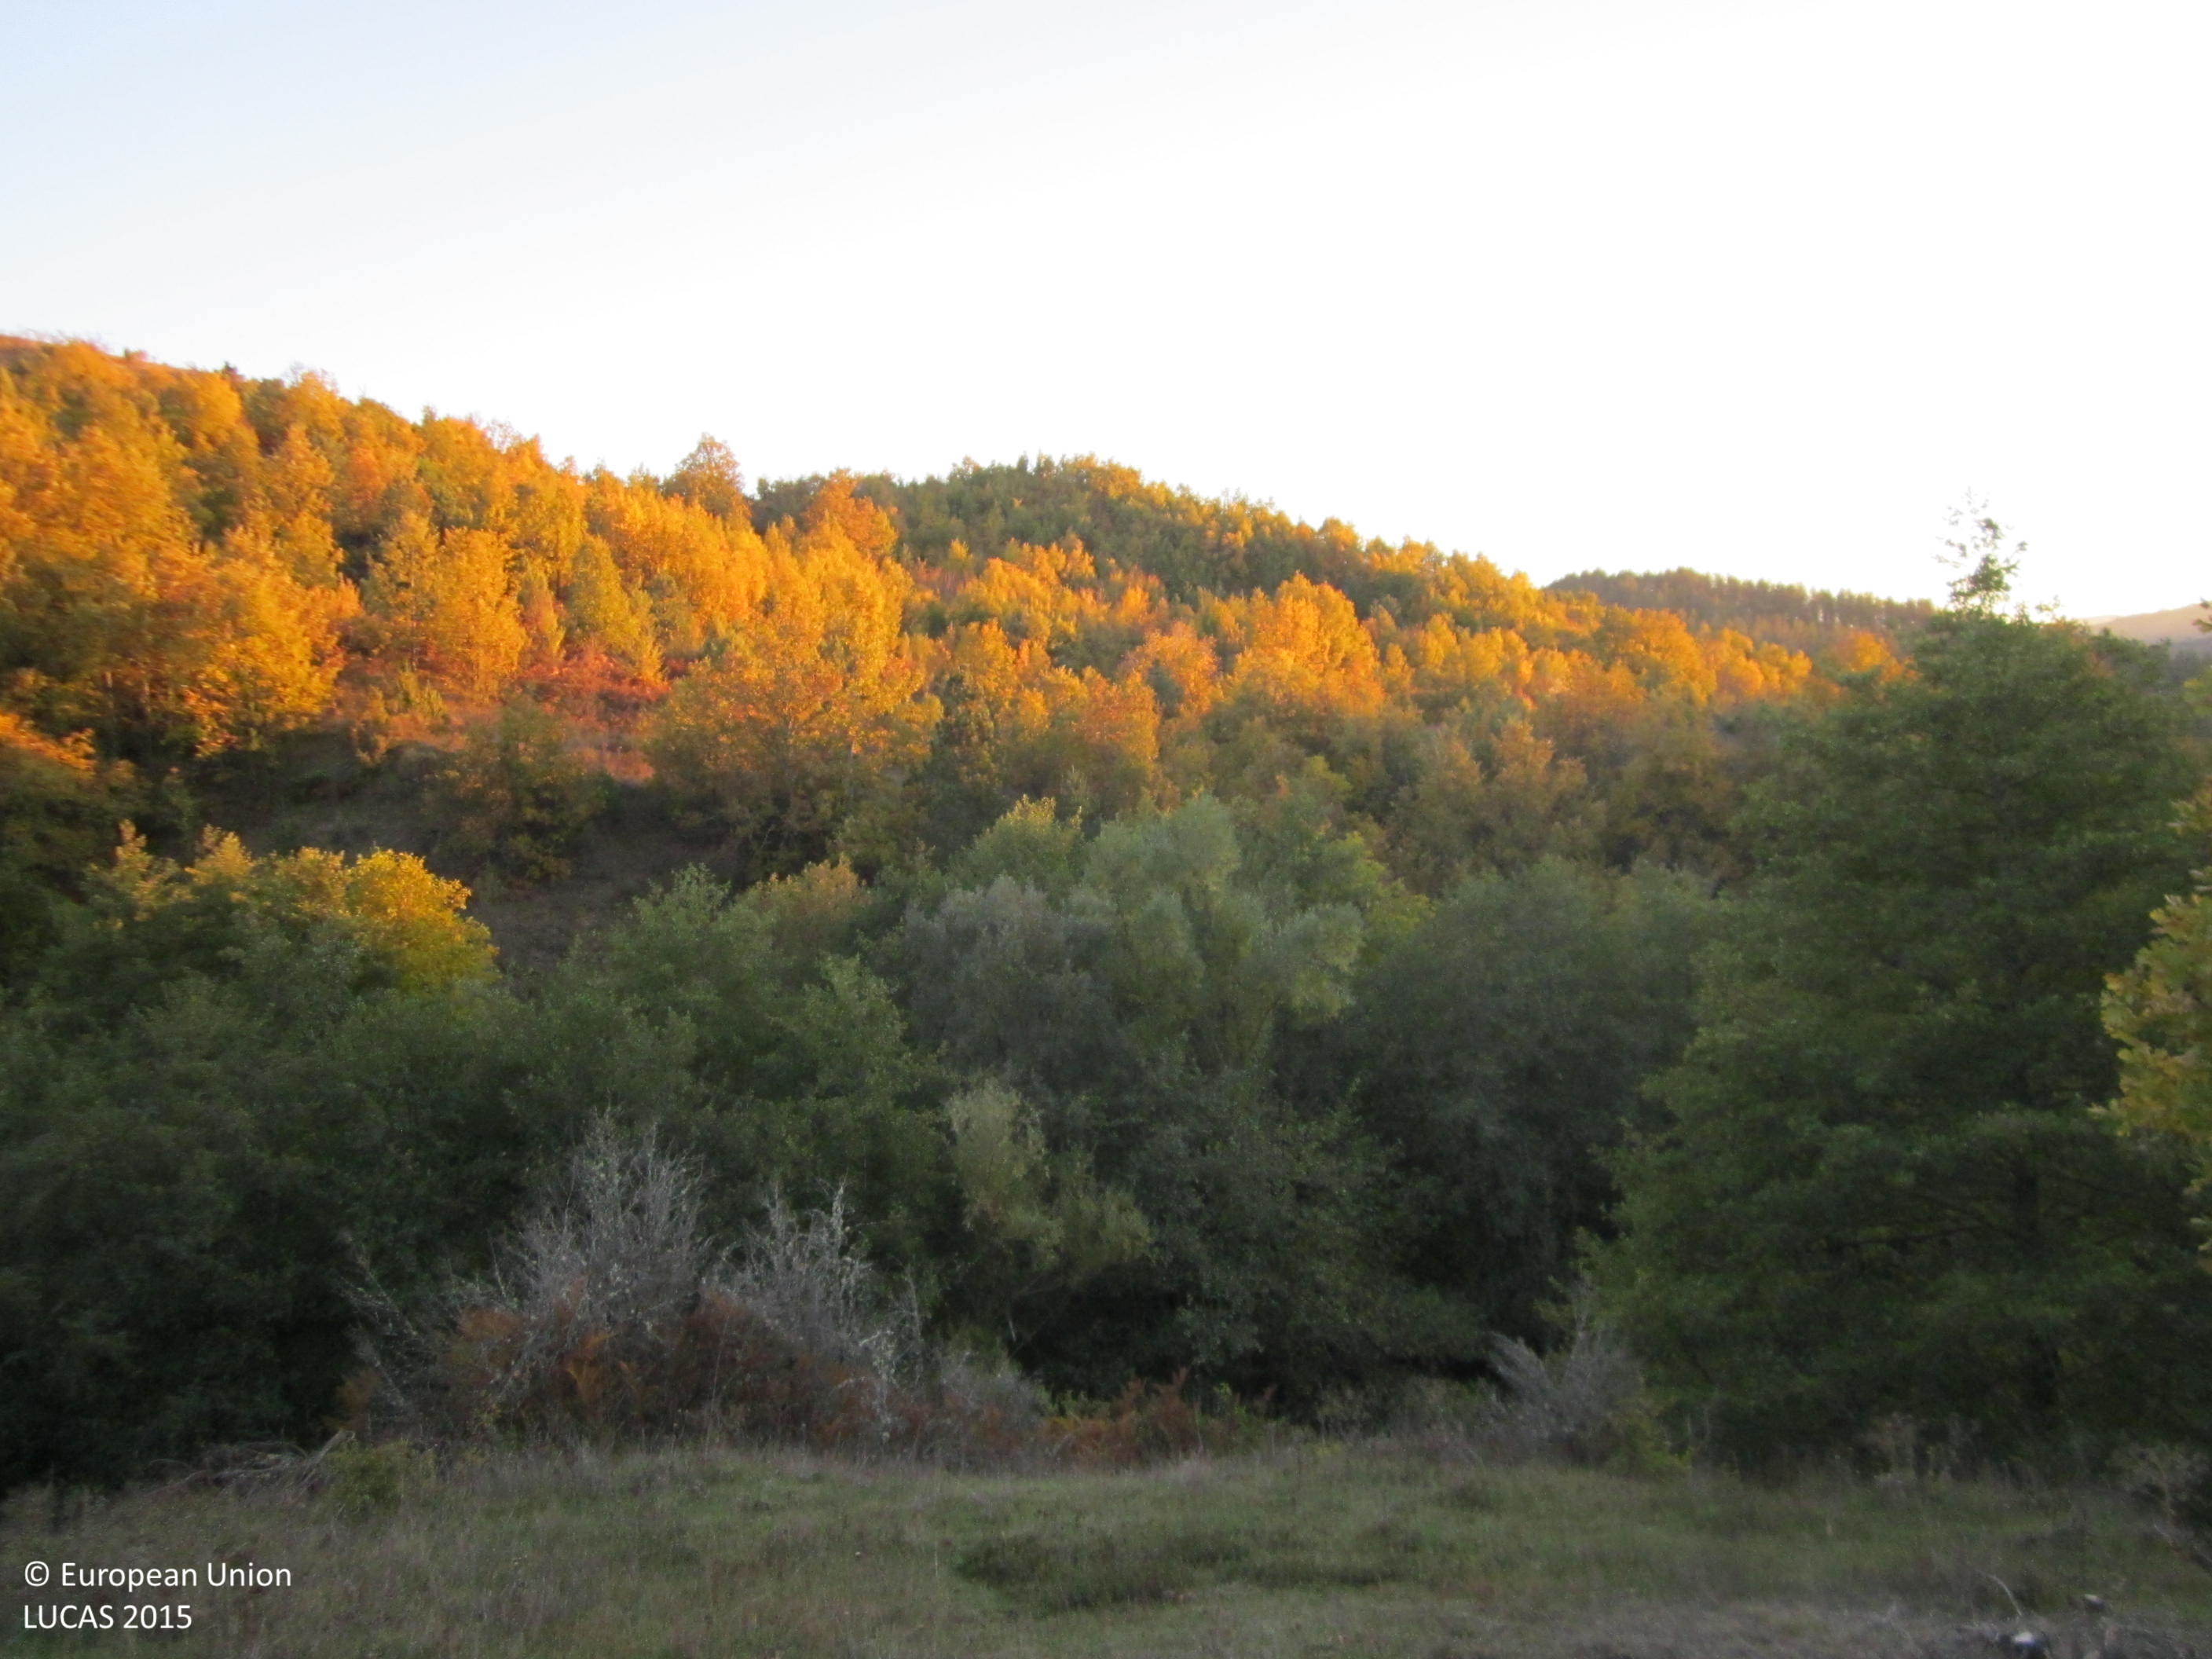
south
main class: Grassland
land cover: Grassland with sparse tree/shrub cover
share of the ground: > 75 %
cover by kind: herbaceous plants 85 %, shrubs 10 %, broadleaved forest trees 5 %
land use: Agriculture (excluding fallow land and kitchen gardens)
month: November
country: BG
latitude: 41.3782
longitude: 25.7364
